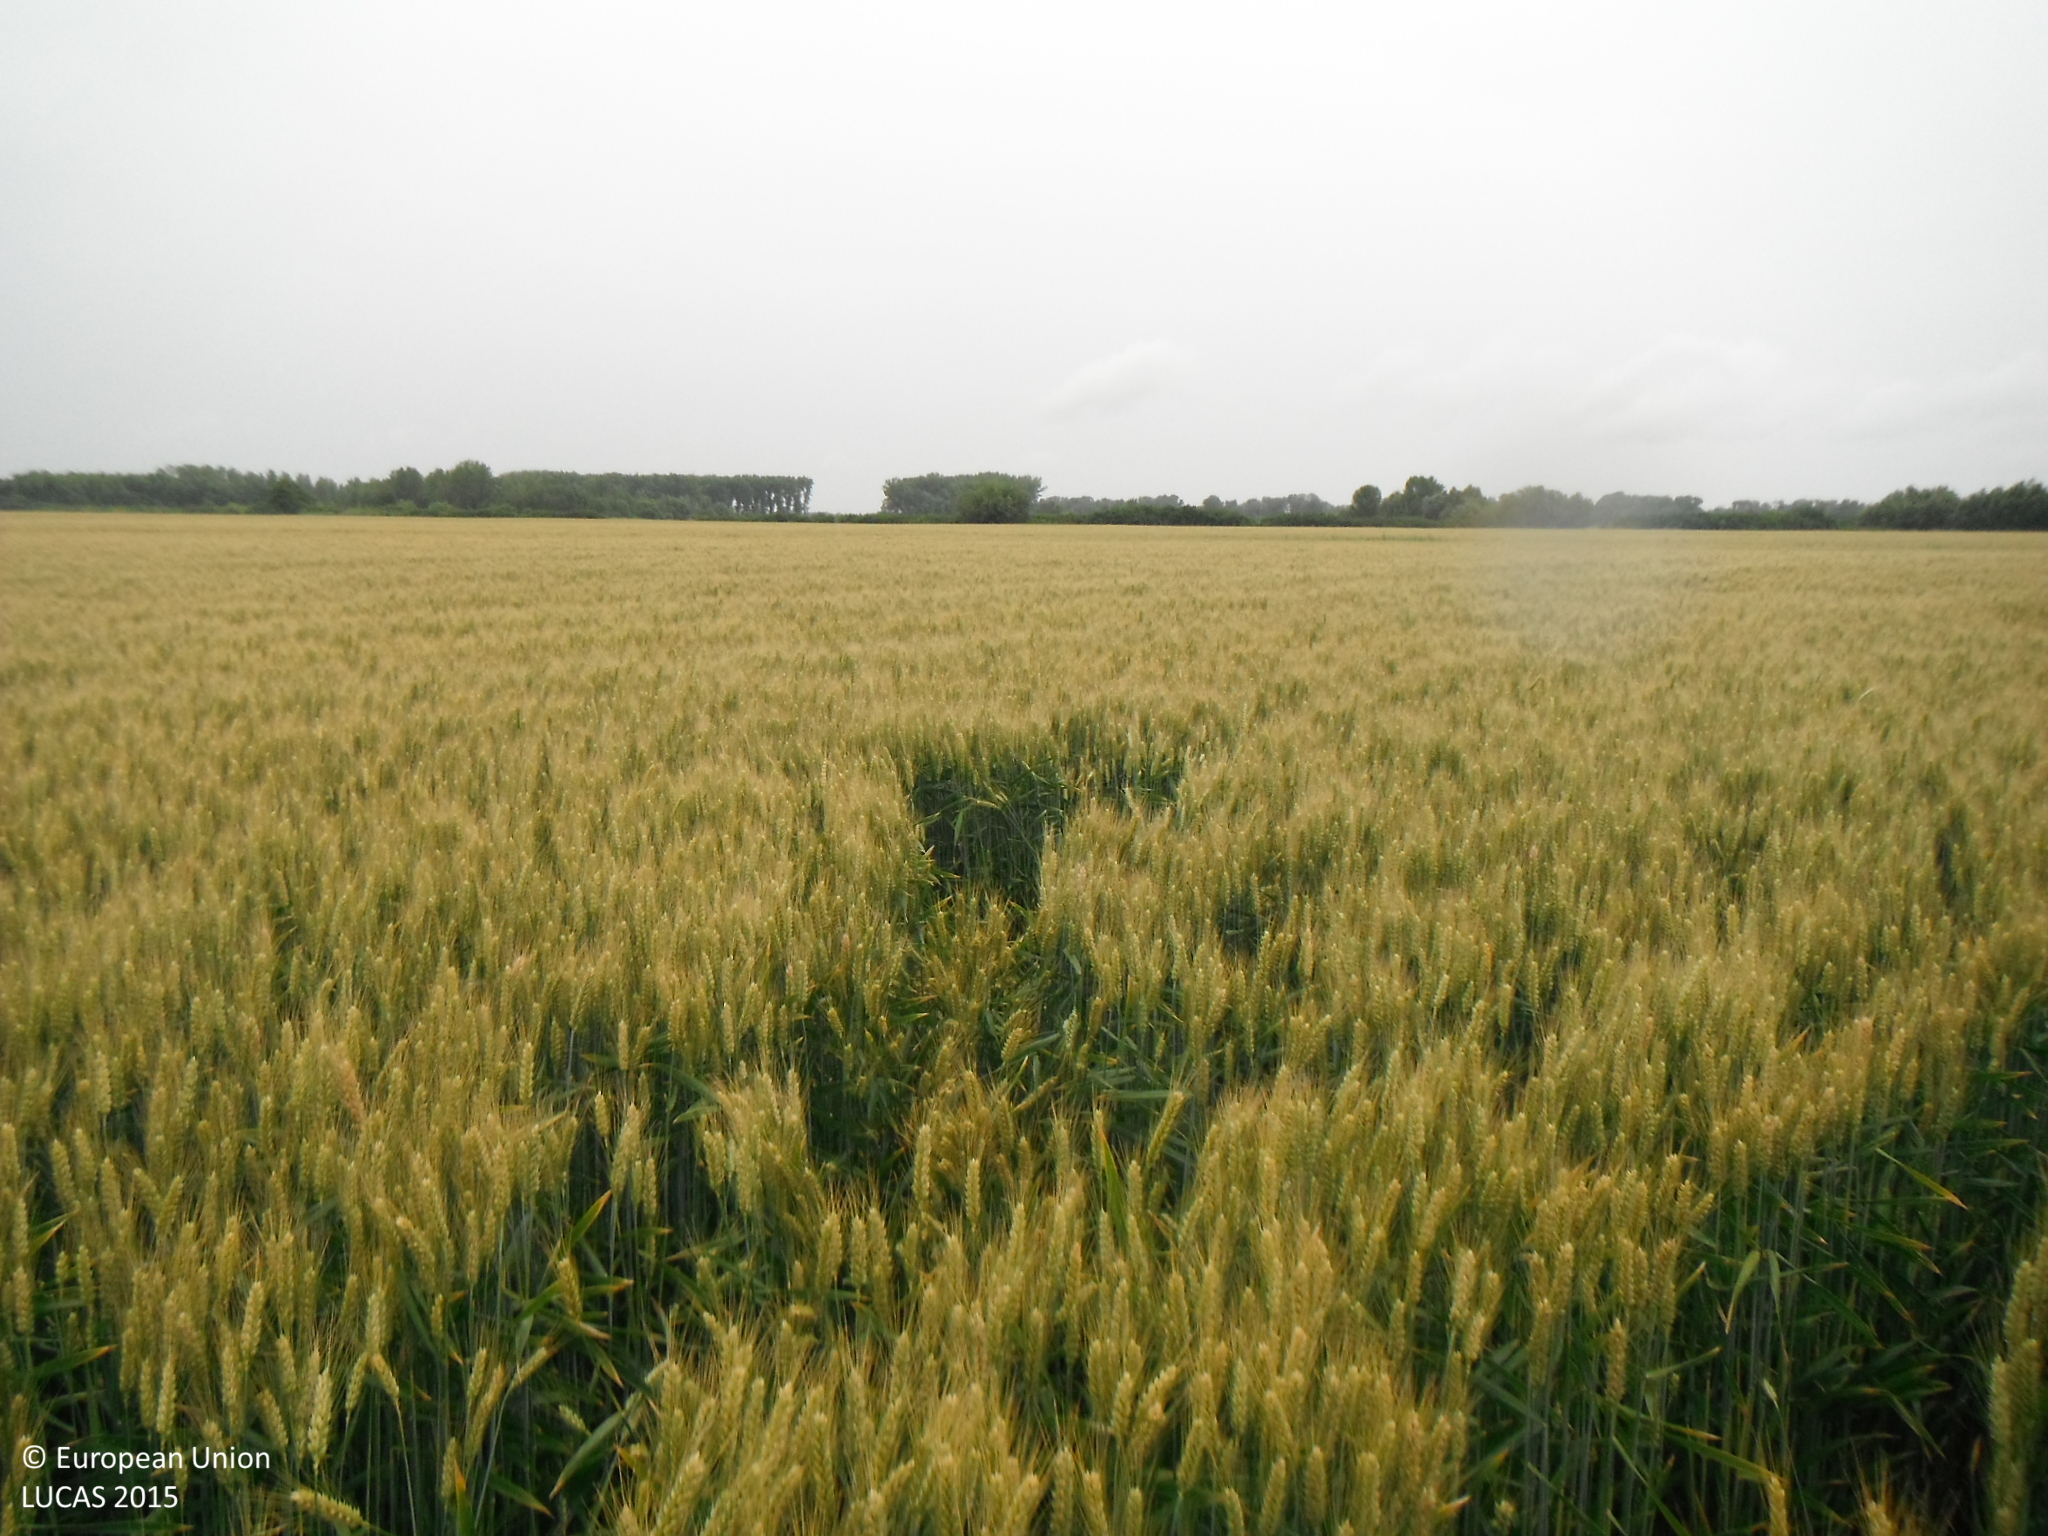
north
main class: Cropland
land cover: Common wheat
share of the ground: > 75 %
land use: Agriculture (excluding fallow land and kitchen gardens)
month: June
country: SK
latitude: 47.9443
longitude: 18.0857
